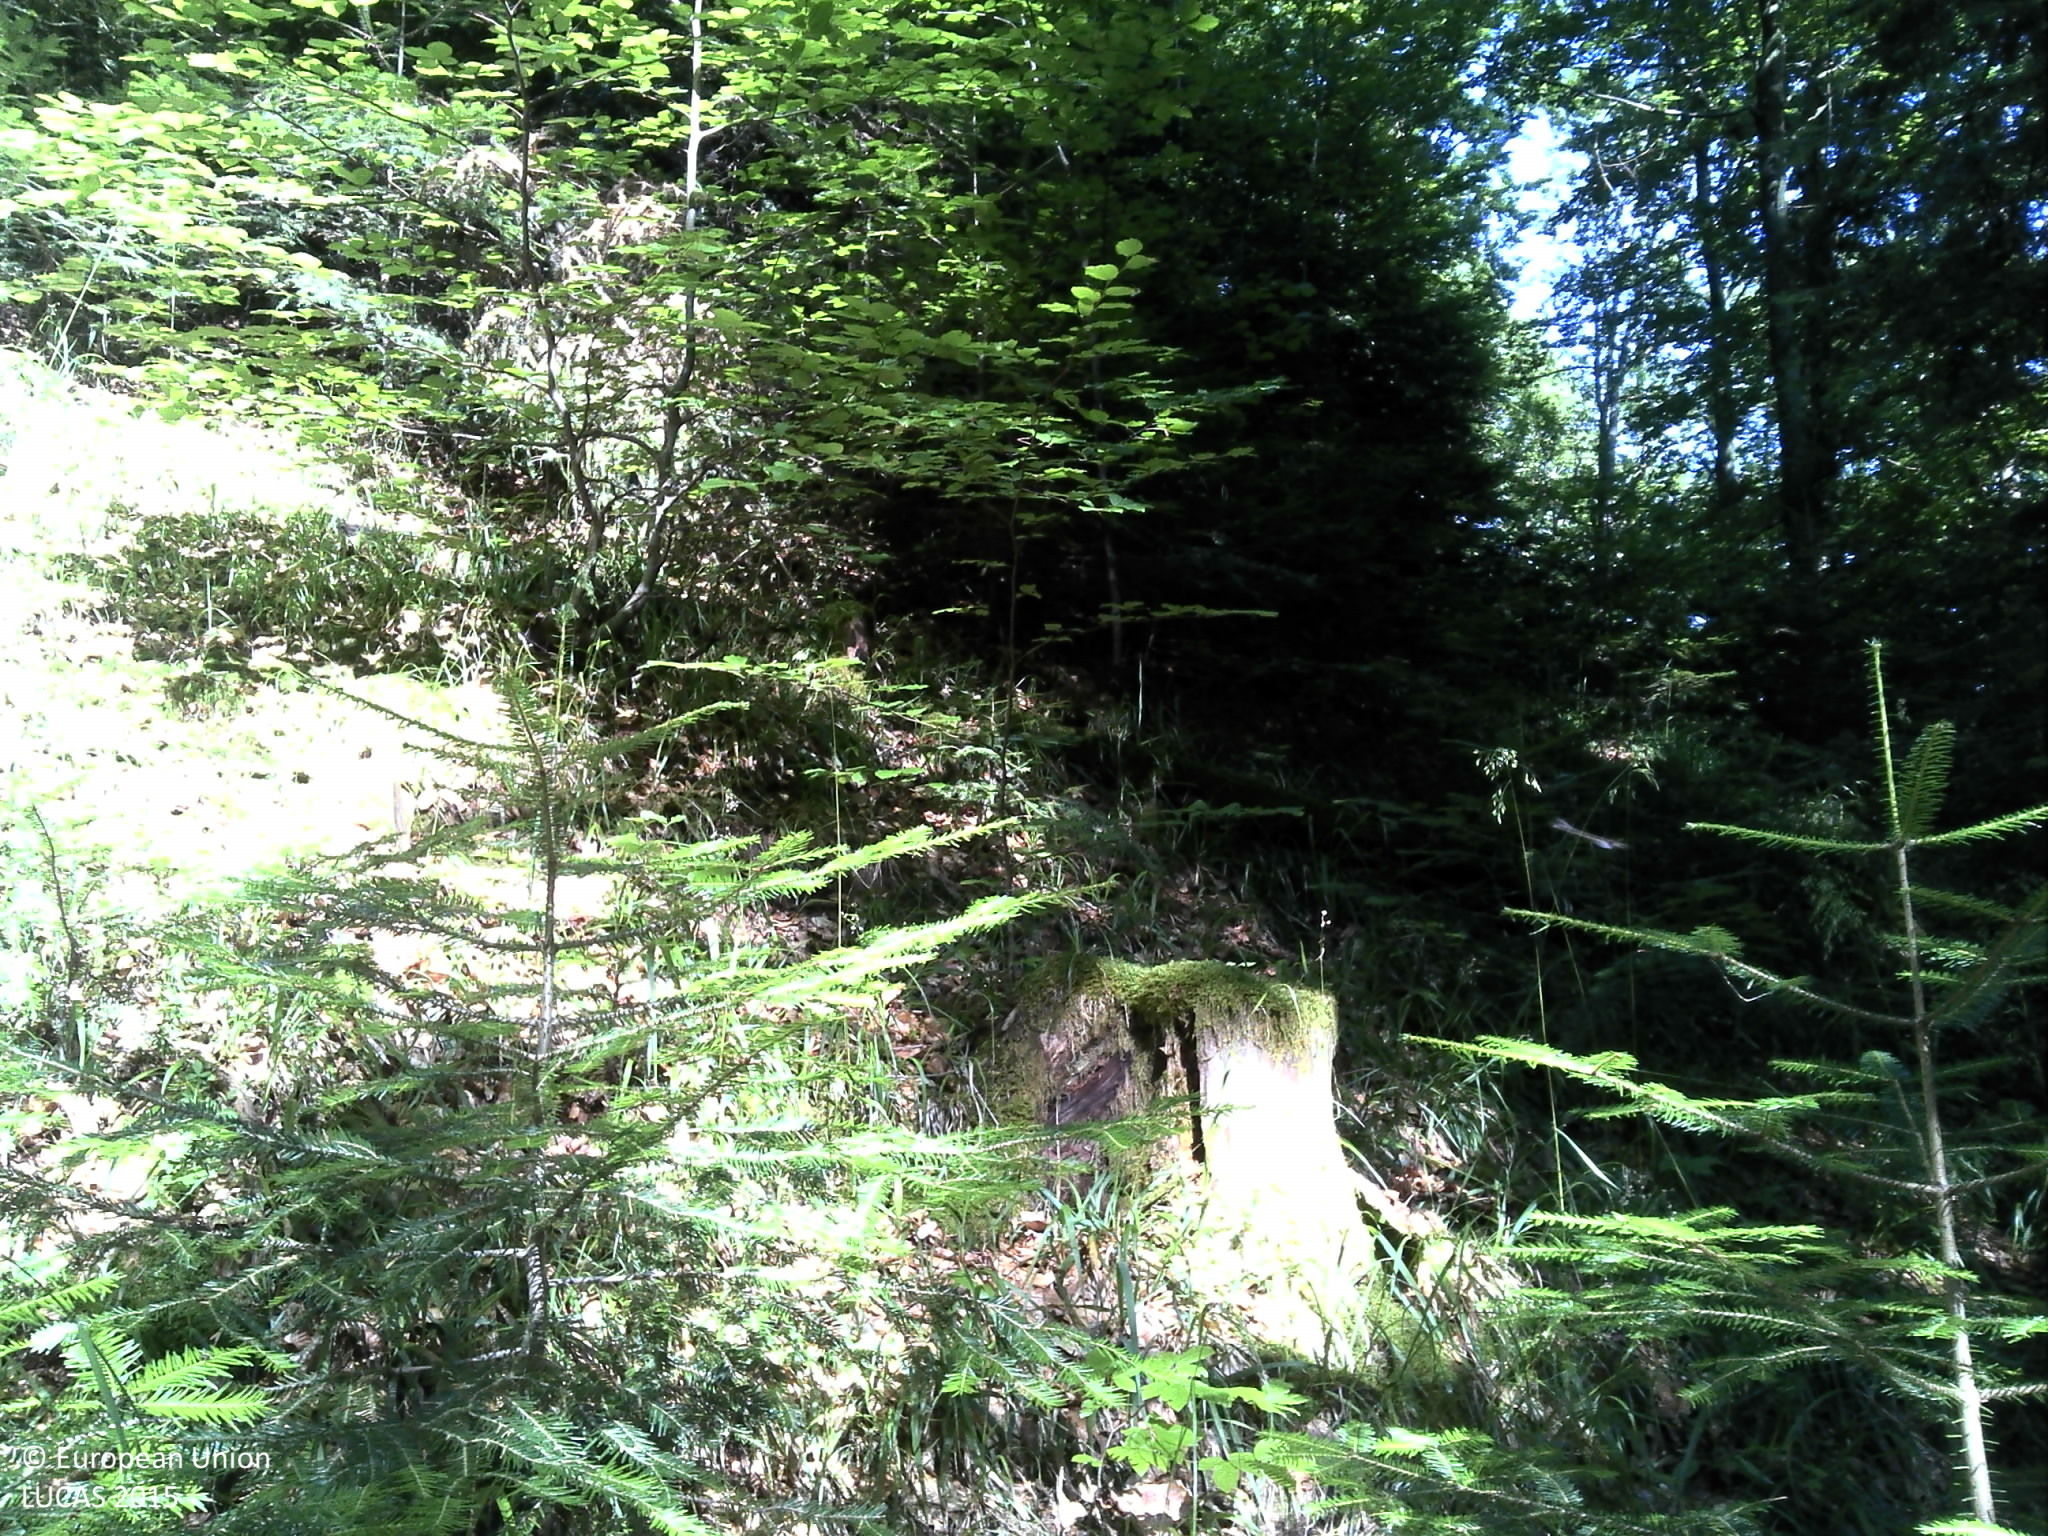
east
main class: Woodland
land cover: Pine dominated mixed woodland
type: broadleaved evergreen forest
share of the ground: > 75 %
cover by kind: coniferous forest trees 50 %, broadleaved forest trees 30 %, lichens and mosses 20 %
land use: Forestry
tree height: > 5 m
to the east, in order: Pine dominated mixed woodland
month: June
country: HR
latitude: 45.5615
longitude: 17.5222
